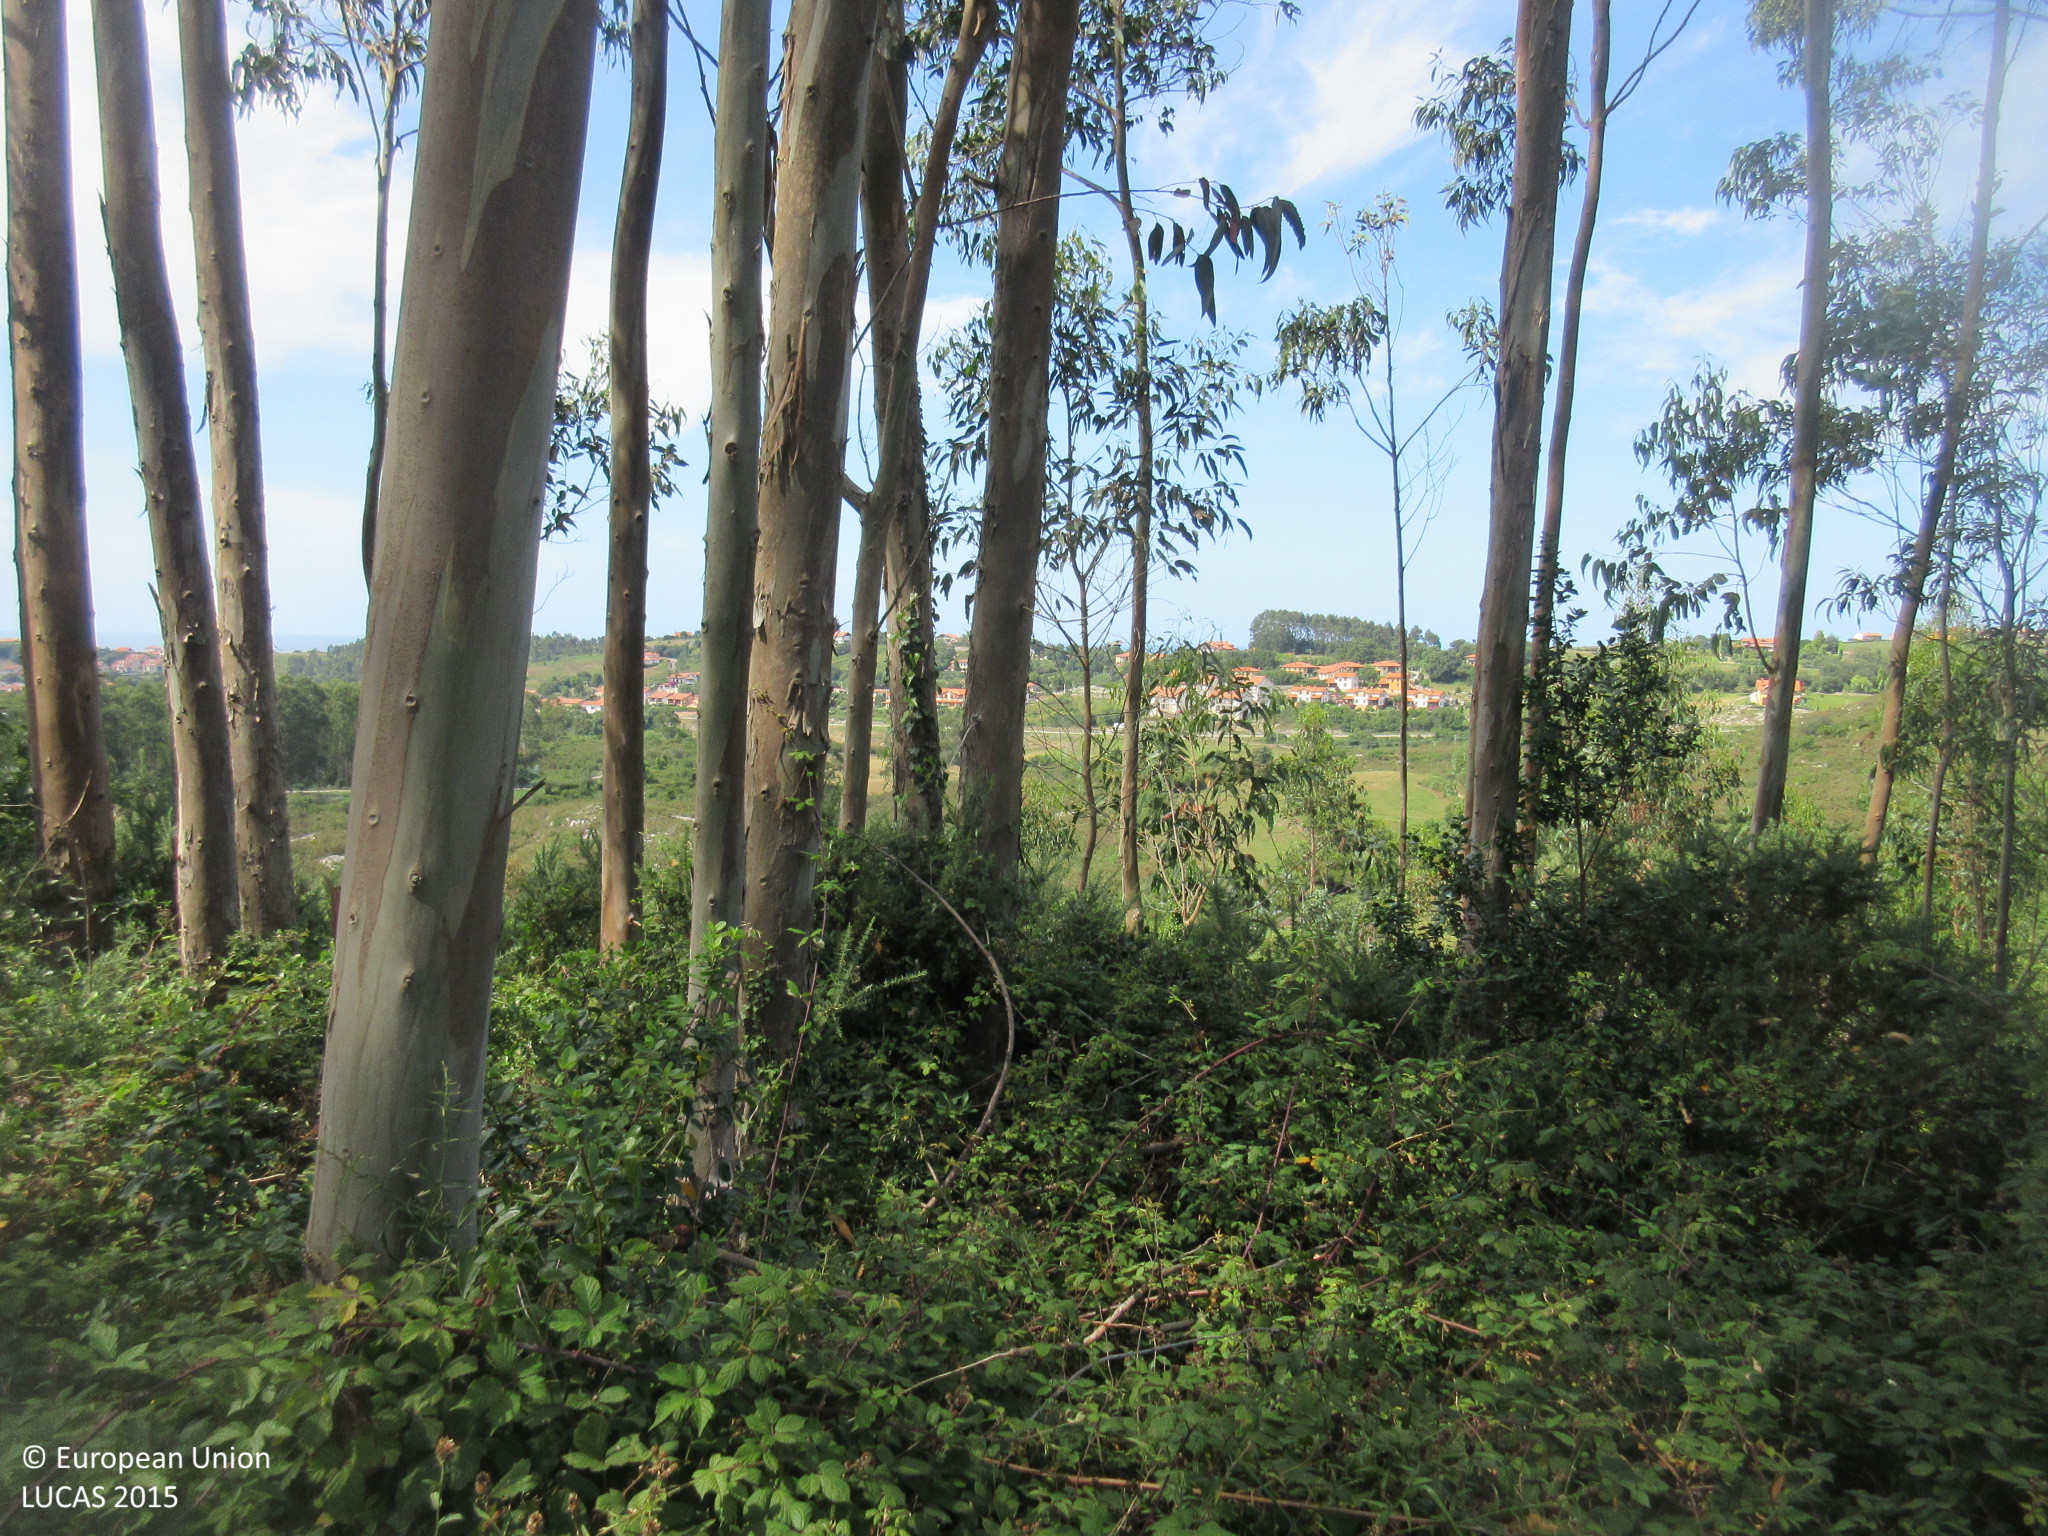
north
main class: Shrubland
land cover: Shrubland with sparse tree cover
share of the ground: > 75 %
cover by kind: shrubs 95 %, broadleaved forest trees 5 %
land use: Forestry
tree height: < 5 m
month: July
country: ES
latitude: 43.3812
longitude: -4.2382
